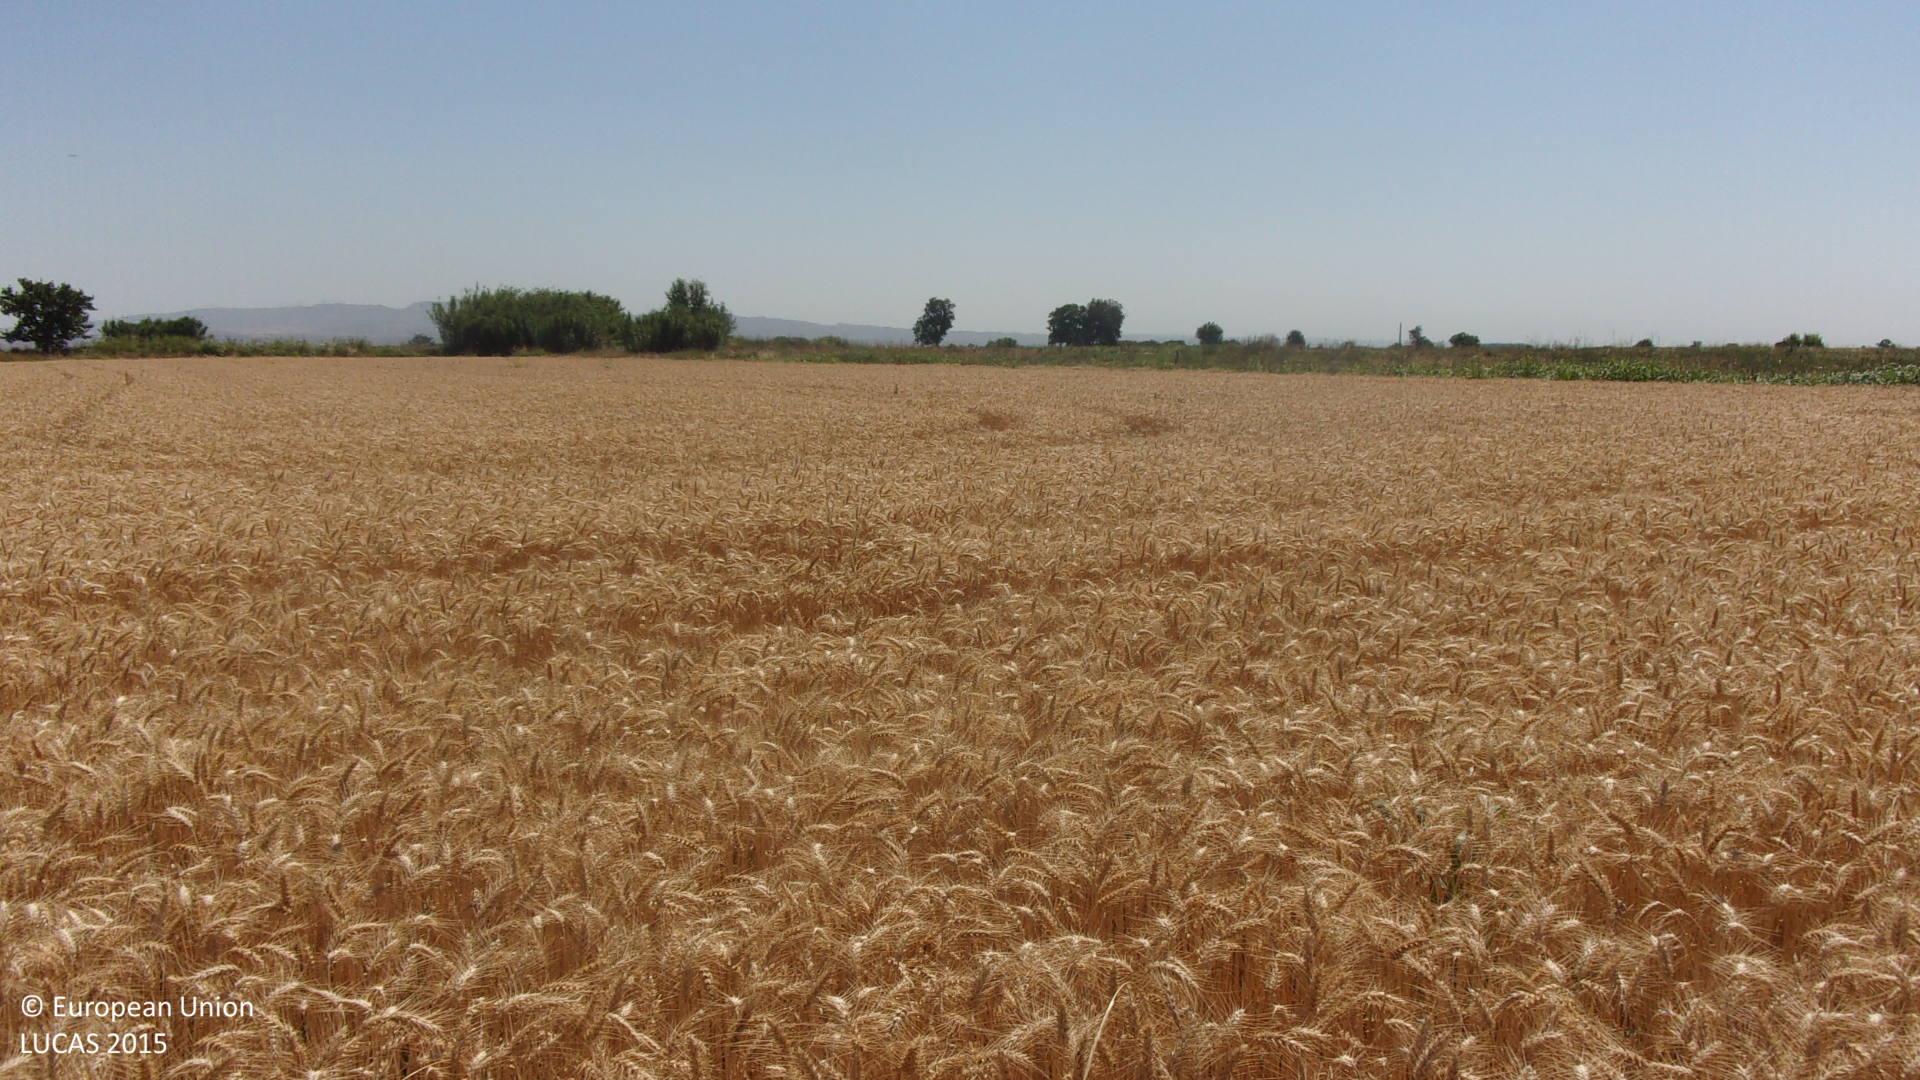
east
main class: Cropland
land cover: Common wheat
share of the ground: > 75 %
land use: Agriculture (excluding fallow land and kitchen gardens)
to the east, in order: Ditches and canals; Common wheat; Grass margins; Tracks; Grass margins; Lucerne; Tracks; Lucerne; Grassland without tree/shrub cover; Lucerne; Grass margins; Lucerne; Grass margins; Ditches and canals; Grass margins; Lucerne; Grass margins; Maize
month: July
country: ES
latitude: 41.8389
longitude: -1.2865
